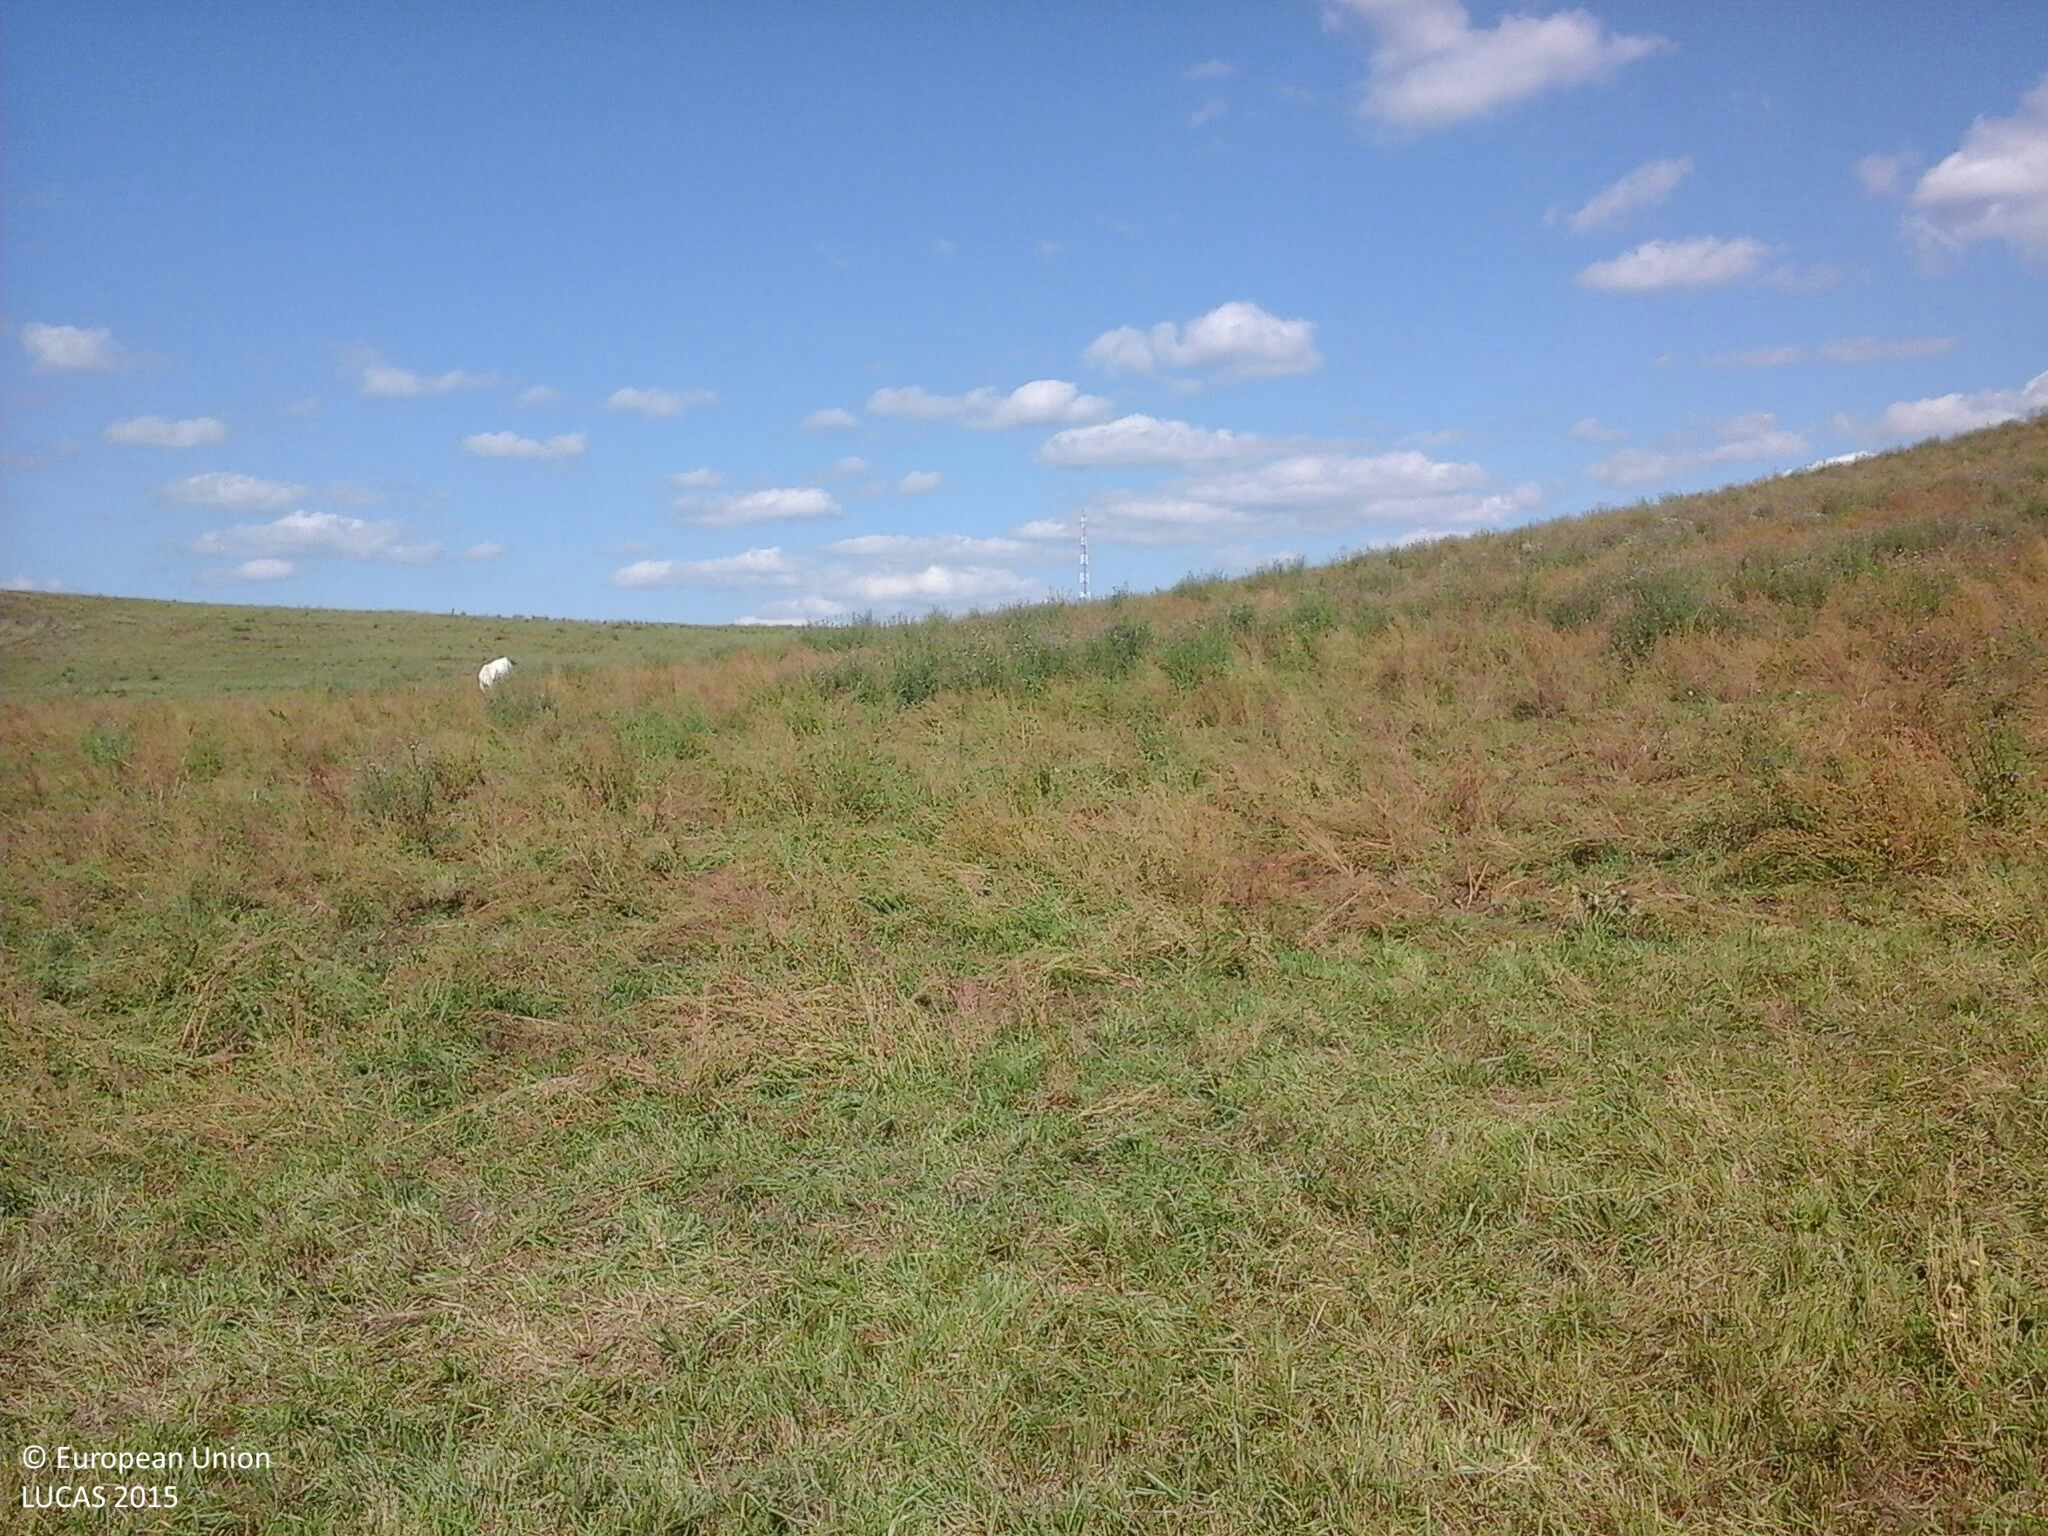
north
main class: Grassland
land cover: Grassland without tree/shrub cover
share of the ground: > 75 %
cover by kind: herbaceous plants 100 %
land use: Agriculture (excluding fallow land and kitchen gardens)
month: September
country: HU
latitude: 48.0369
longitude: 19.8307
